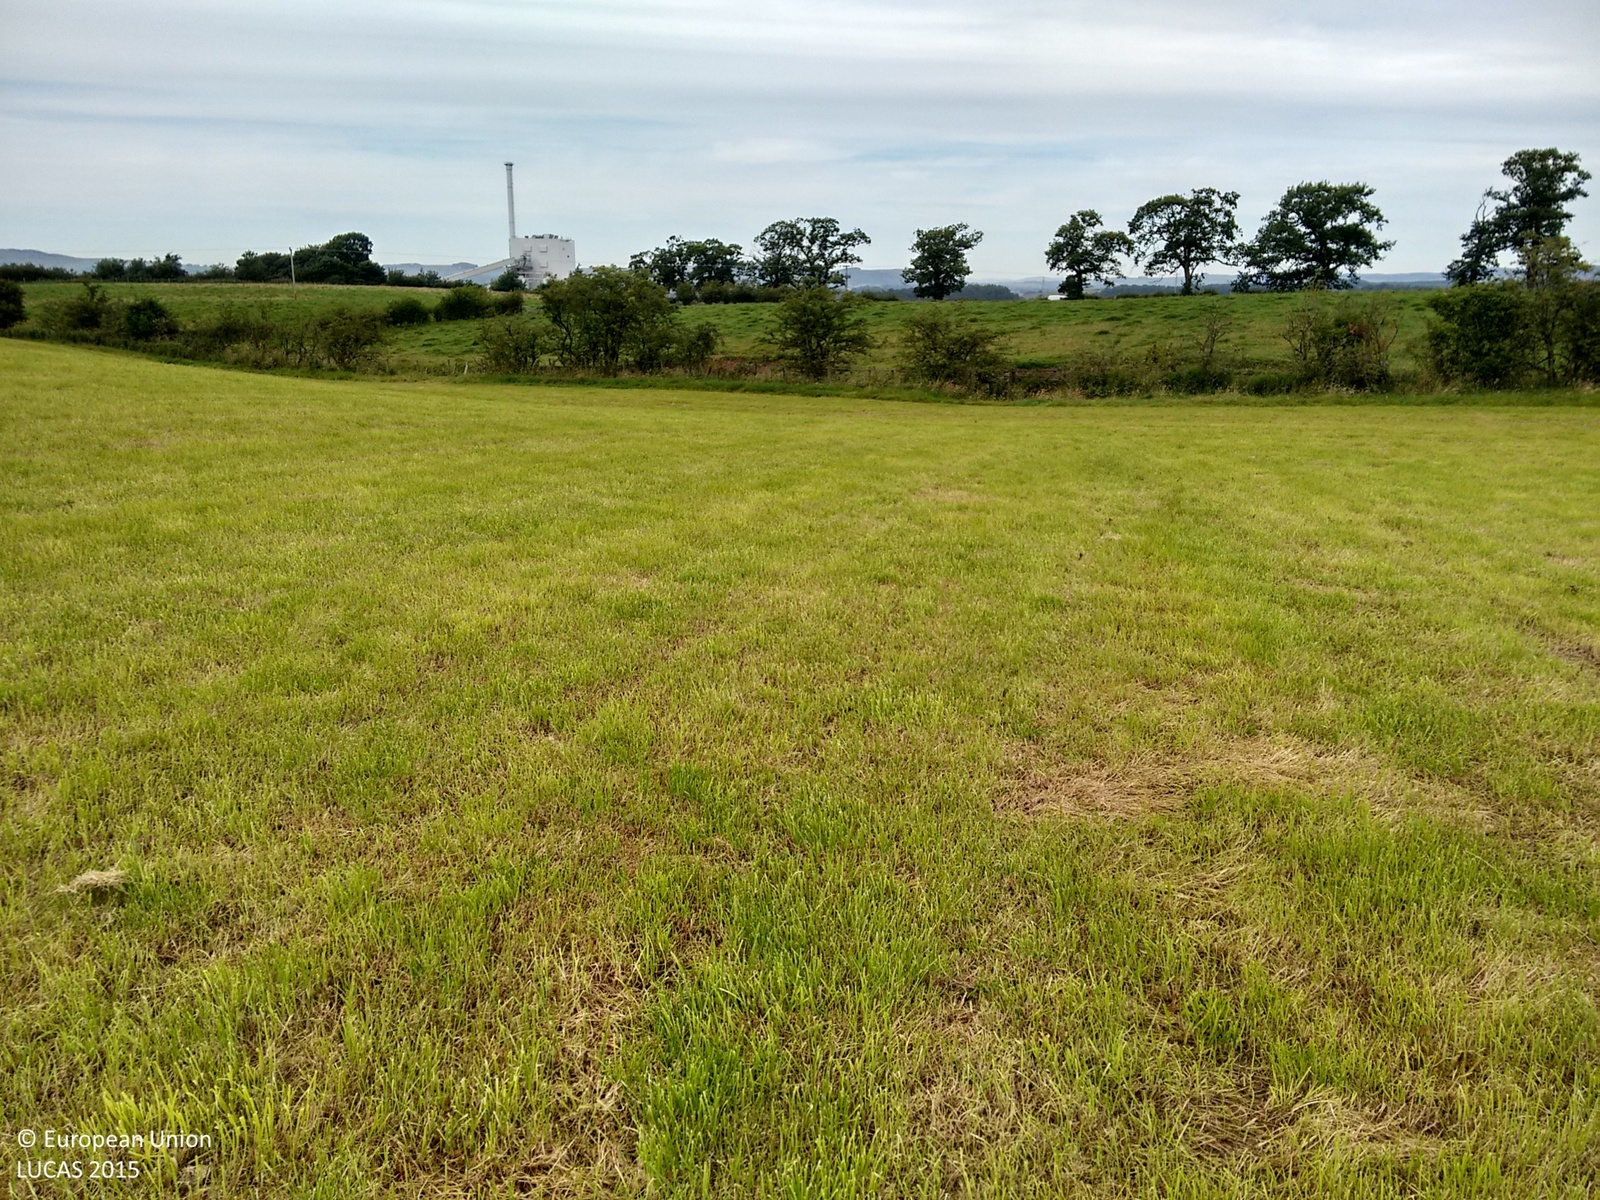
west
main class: Grassland
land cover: Grassland without tree/shrub cover
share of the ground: > 75 %
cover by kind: herbaceous plants 80 %, unconsolidated bare surface 20 %
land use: Agriculture (excluding fallow land and kitchen gardens)
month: August
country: GB
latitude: 55.1553
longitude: -3.3702
